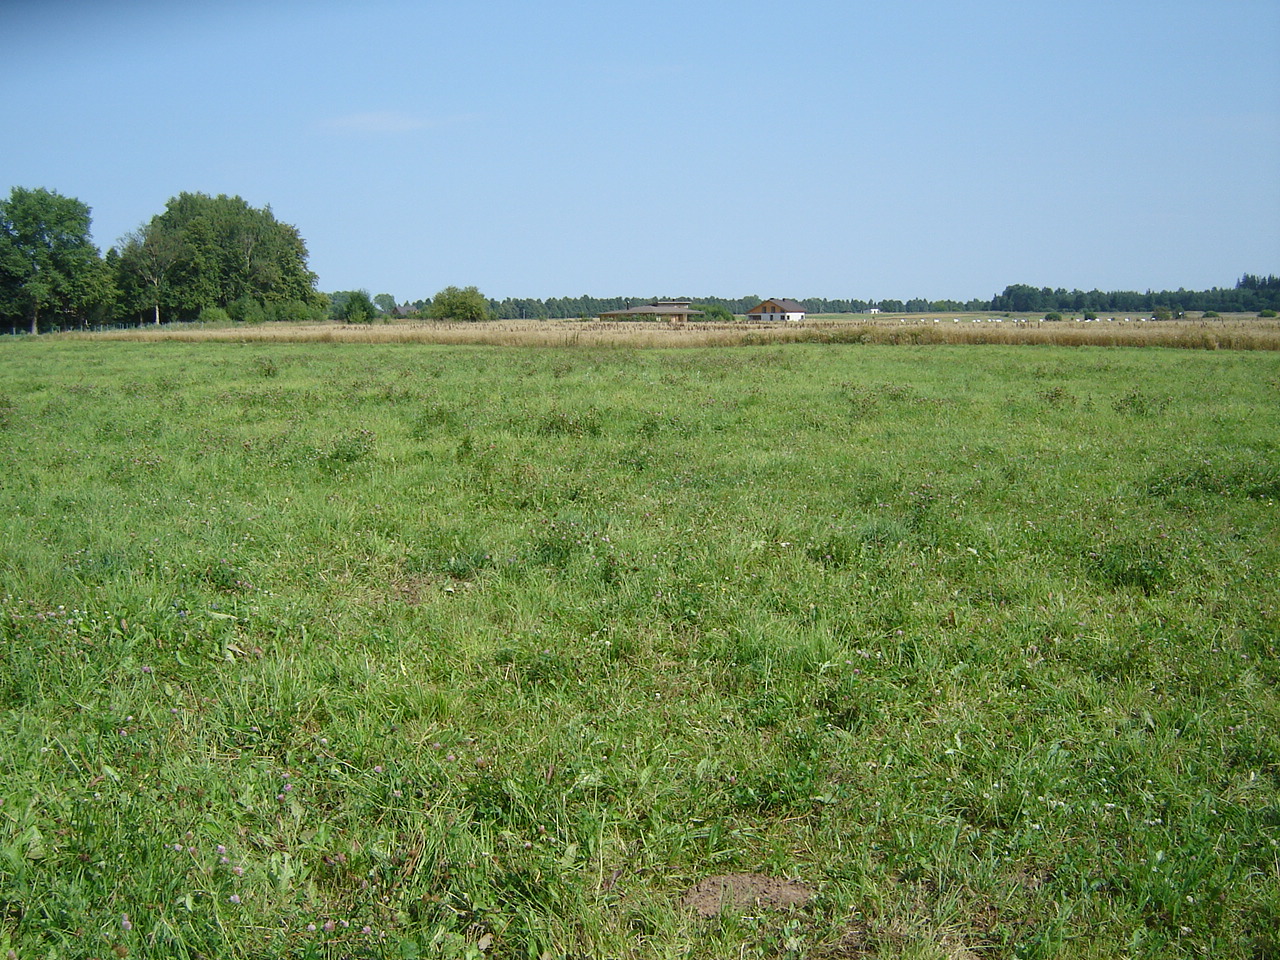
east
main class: Grassland
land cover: Grassland without tree/shrub cover
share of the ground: > 75 %
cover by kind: herbaceous plants 100 %
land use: Agriculture (excluding fallow land and kitchen gardens)
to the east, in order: Grassland without tree/shrub cover; Durum wheat; Grass margins; Tracks; Grass margins; Paved roads, cycling and walking lanes; Grassland without tree/shrub cover
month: August
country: LT
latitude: 55.0289
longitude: 24.9588
